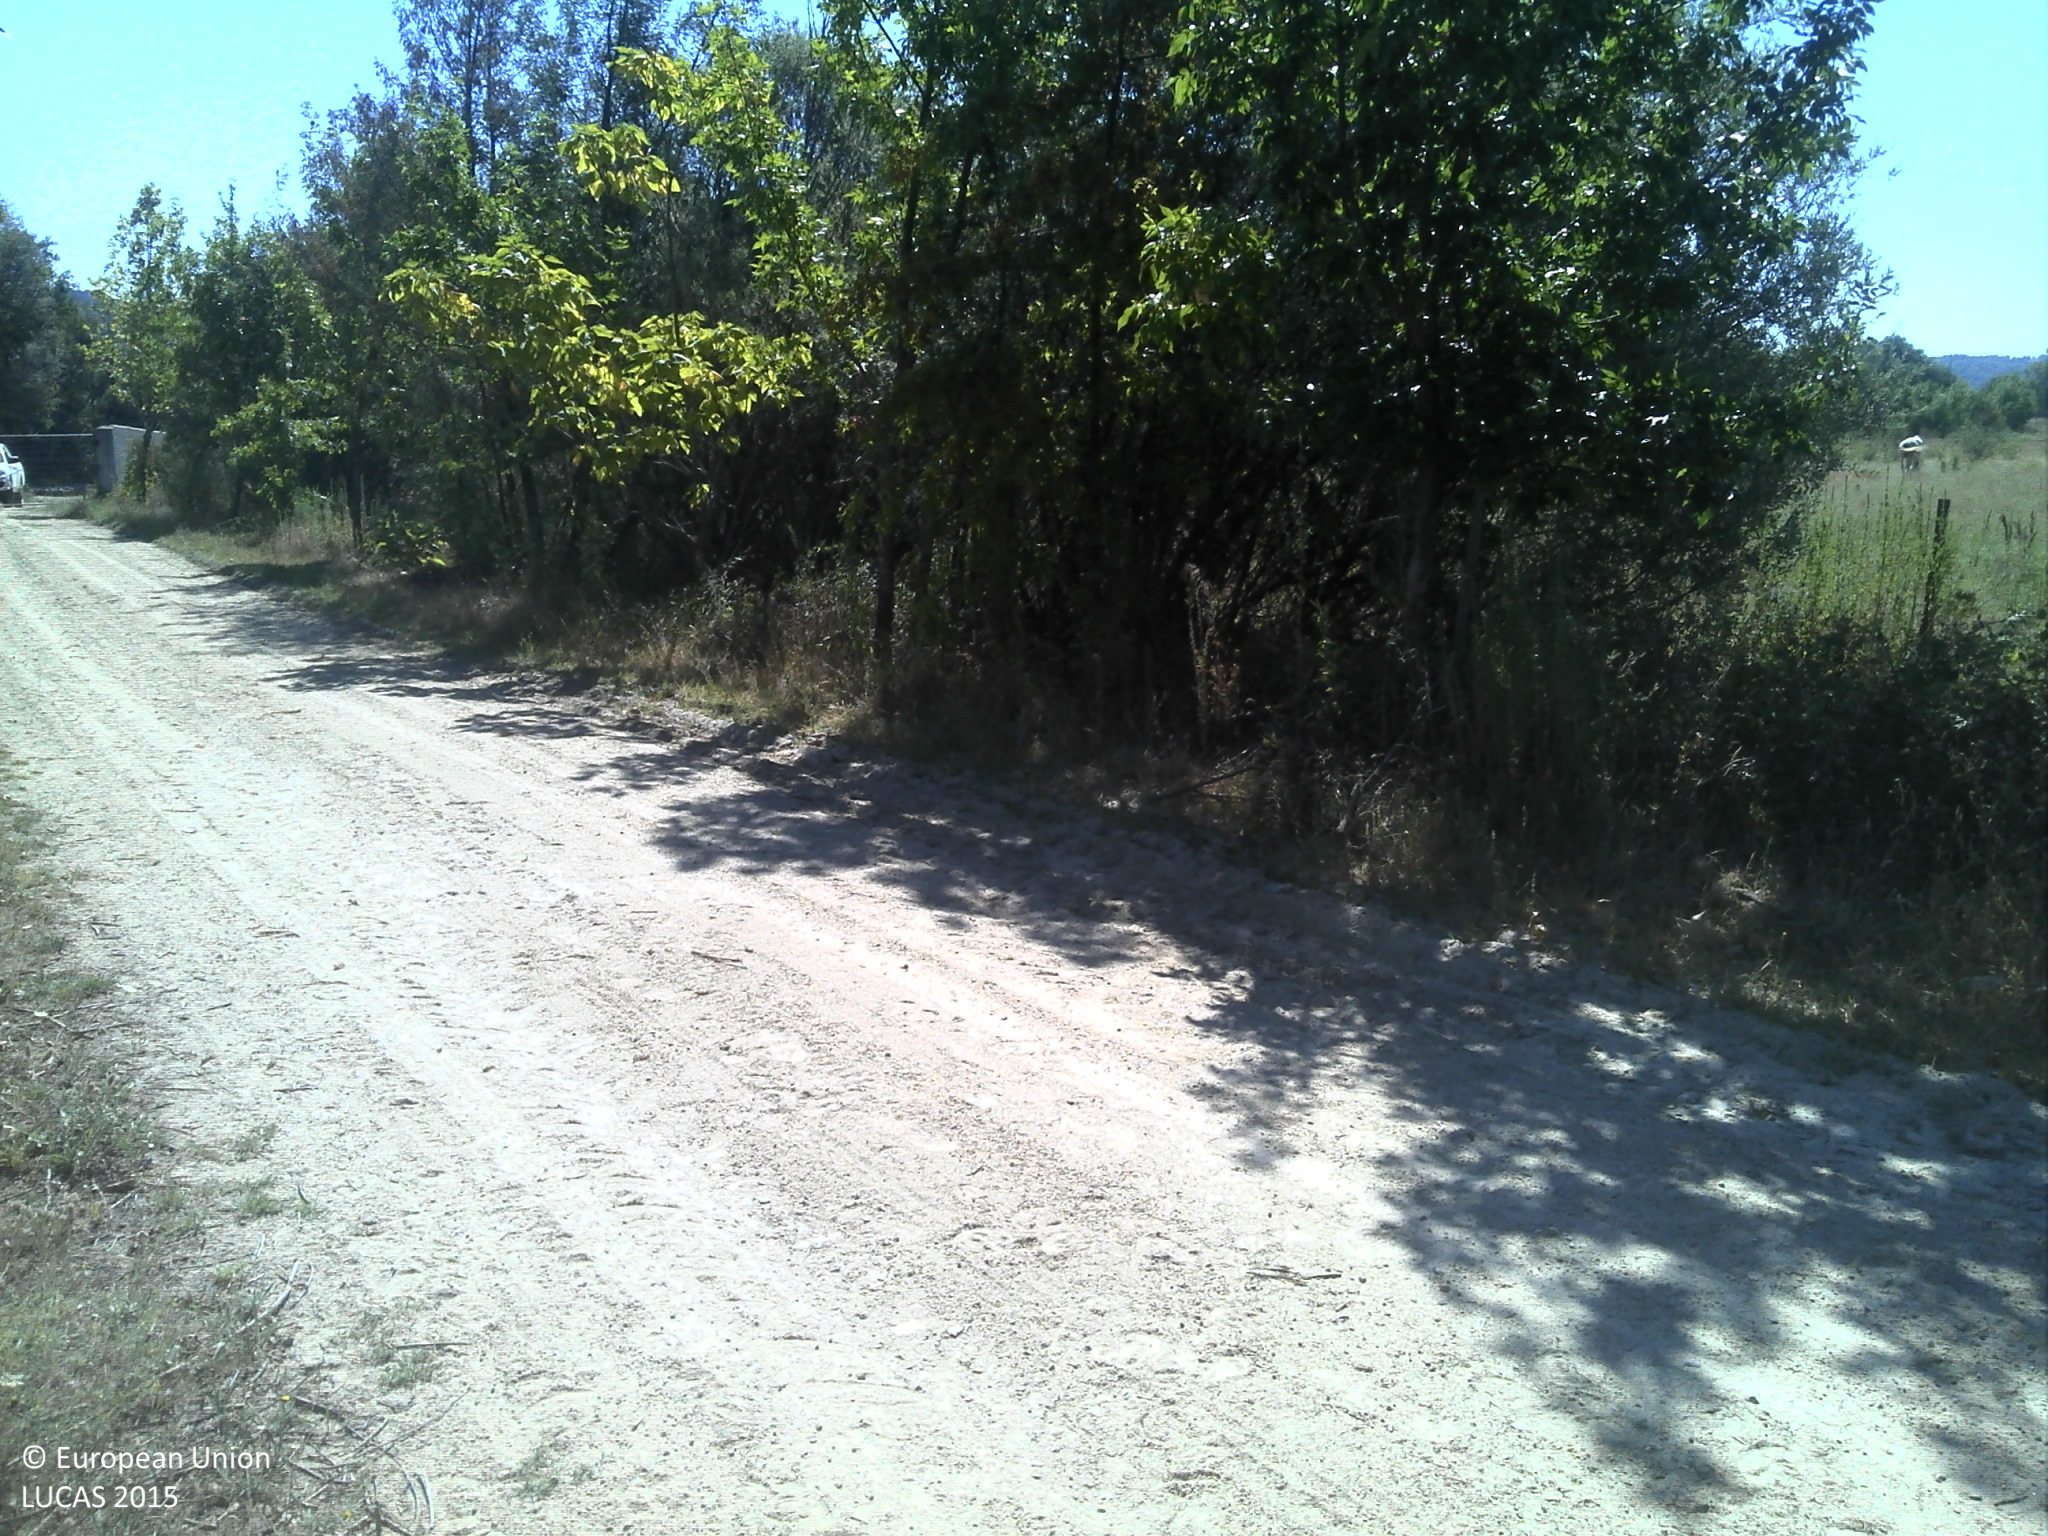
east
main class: Woodland
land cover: Broadleaved woodland
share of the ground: 25 - 50 %
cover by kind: shrubs 45 %, broadleaved forest trees 25 %, herbaceous plants 15 %, unconsolidated bare surface 15 %
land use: Semi-natural and natural areas not in use
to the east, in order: Broadleaved woodland; Tracks; Abandoned hedges; Fences; Spontaneously vegetated surfaces; Fences; Tracks; Broadleaved woodland; Inland fresh running water; Broadleaved woodland; Shrubland without tree cover; Tracks; Grassland without tree/shrub cover; Broadleaved woodland
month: July
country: PT
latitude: 40.3849
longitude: -7.3628
